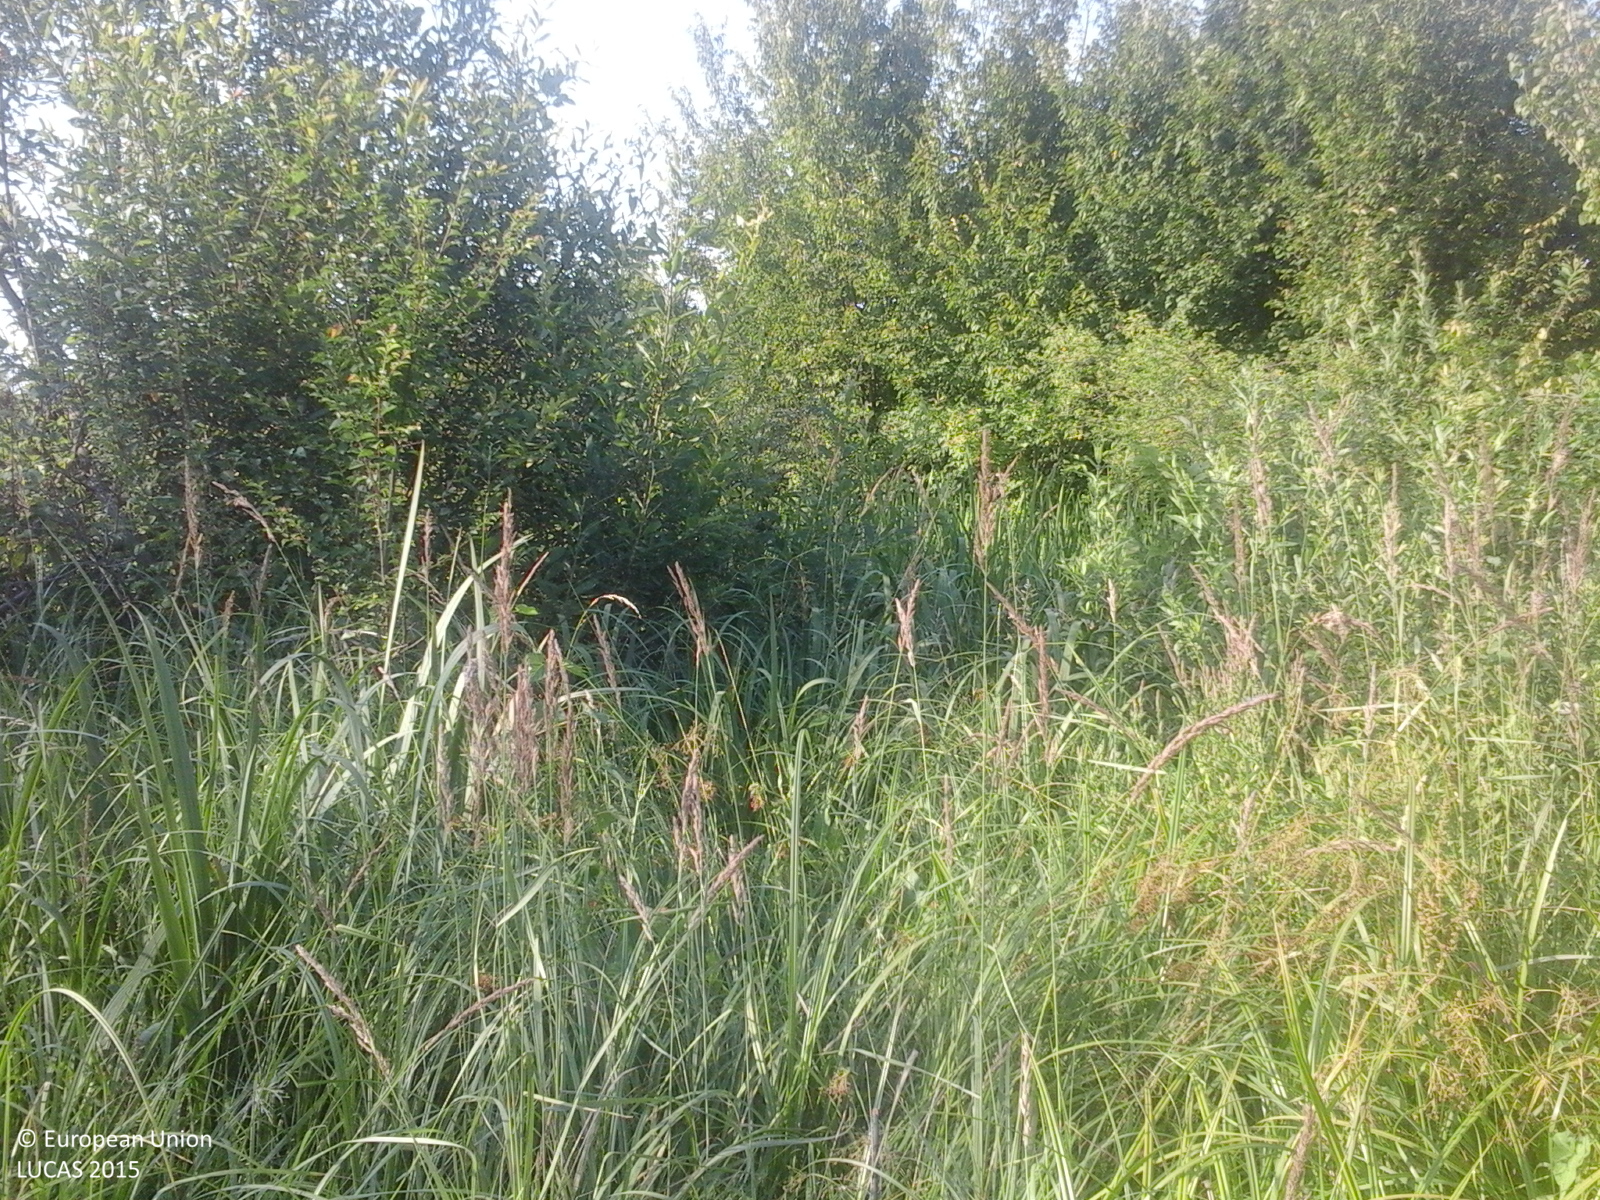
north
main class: Grassland
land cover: Grassland with sparse tree/shrub cover
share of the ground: > 75 %
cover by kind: herbaceous plants 85 %, shrubs 10 %, broadleaved forest trees 5 %
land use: Semi-natural and natural areas not in use
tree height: > 5 m
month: July
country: RO
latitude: 44.5224
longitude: 24.7080
